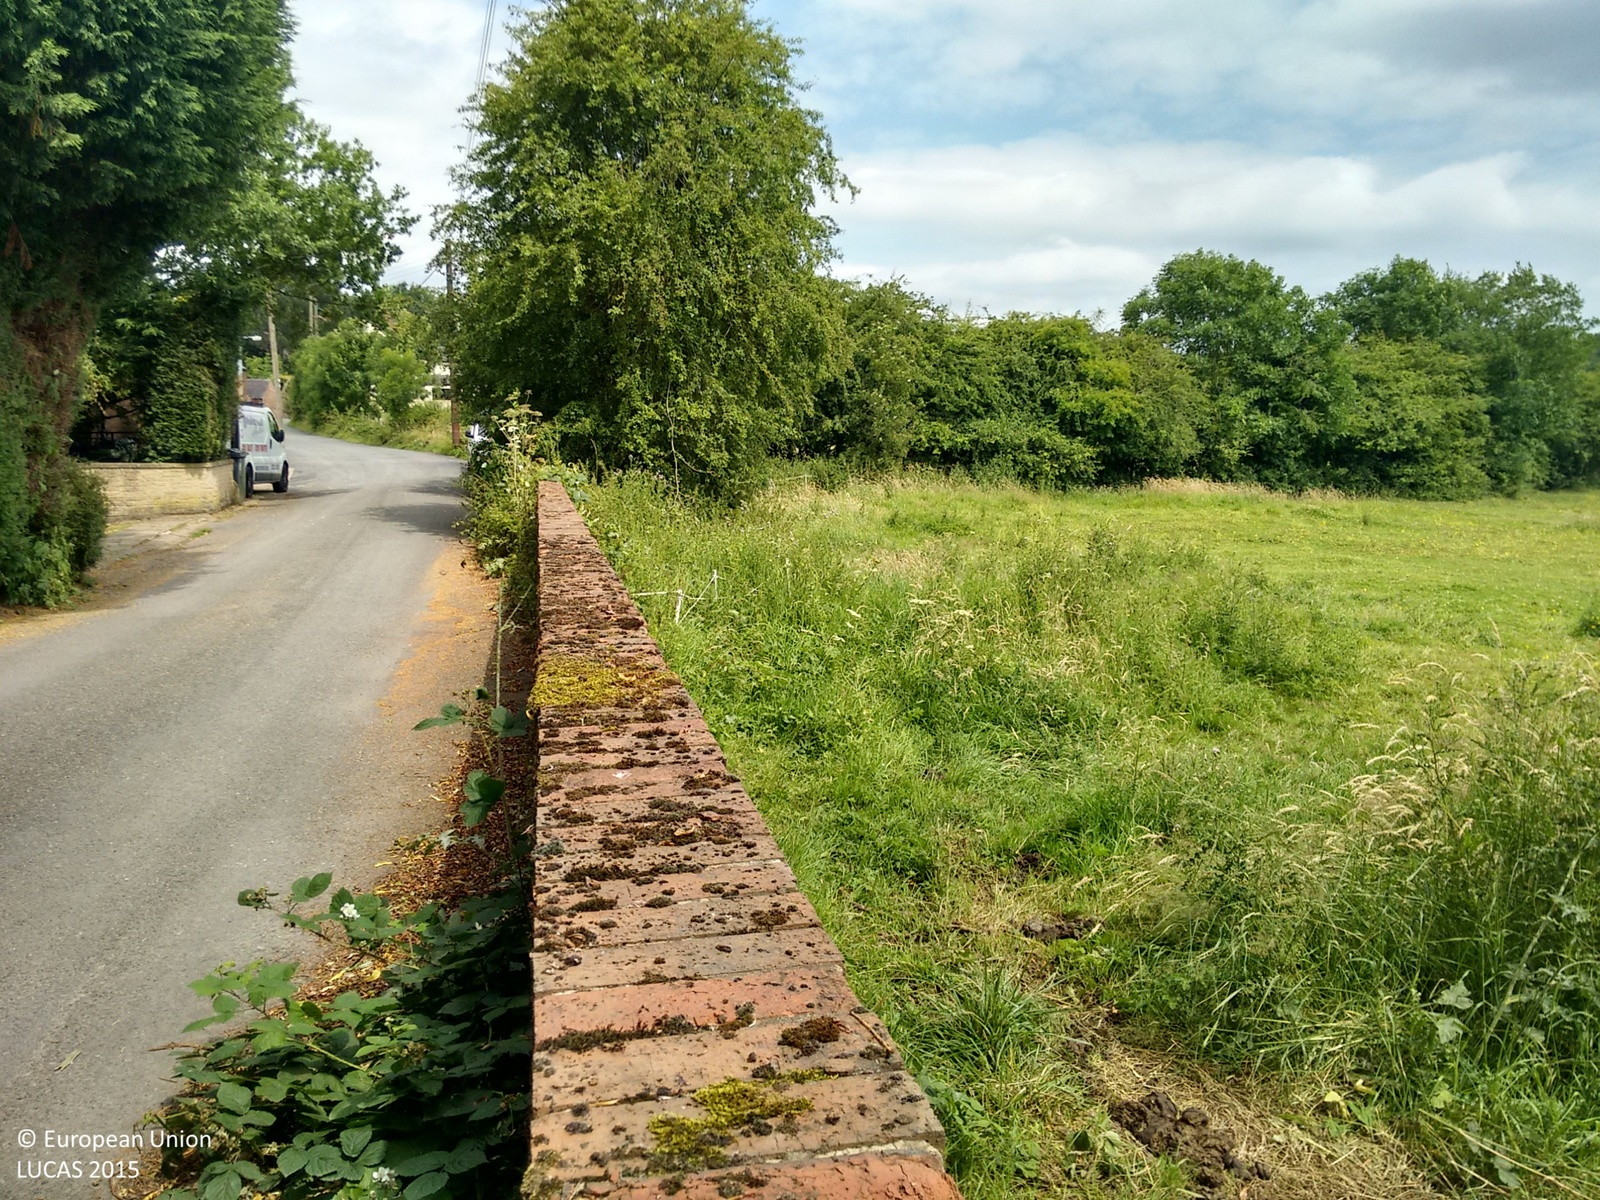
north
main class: Grassland
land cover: Grassland without tree/shrub cover
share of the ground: > 75 %
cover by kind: herbaceous plants 100 %
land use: Agriculture (excluding fallow land and kitchen gardens)
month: July
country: GB
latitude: 53.0581
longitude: -1.4341
